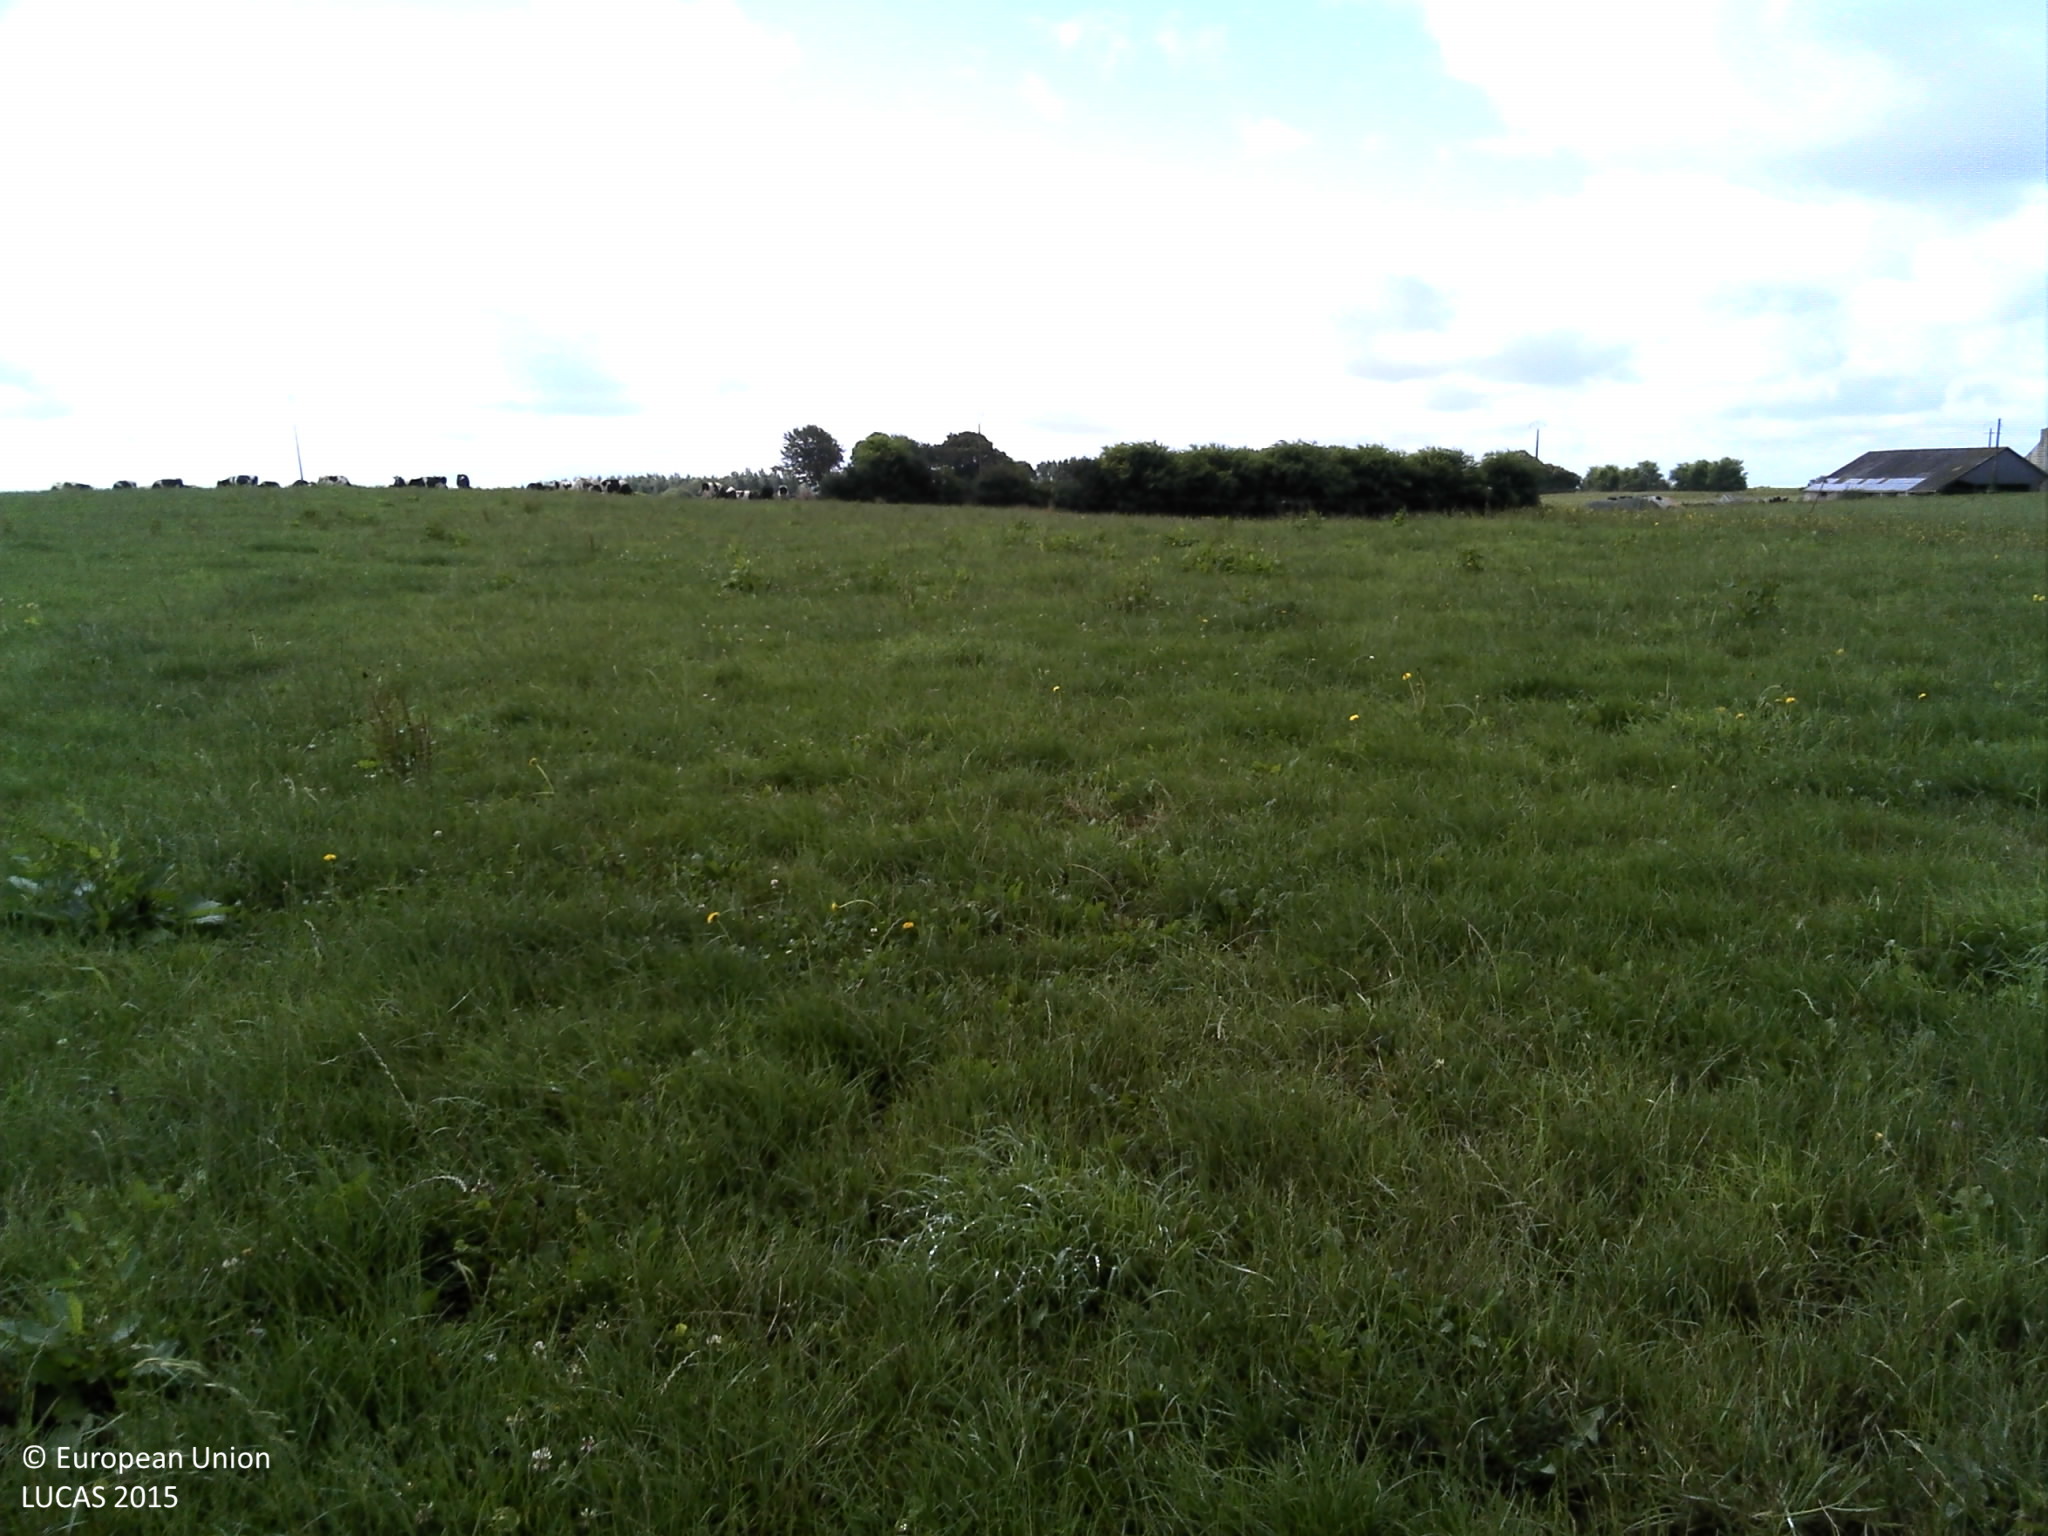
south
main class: Grassland
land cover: Grassland without tree/shrub cover
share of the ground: > 75 %
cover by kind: herbaceous plants 100 %
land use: Agriculture (excluding fallow land and kitchen gardens)
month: July
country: FR
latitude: 48.0943
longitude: -4.1204
